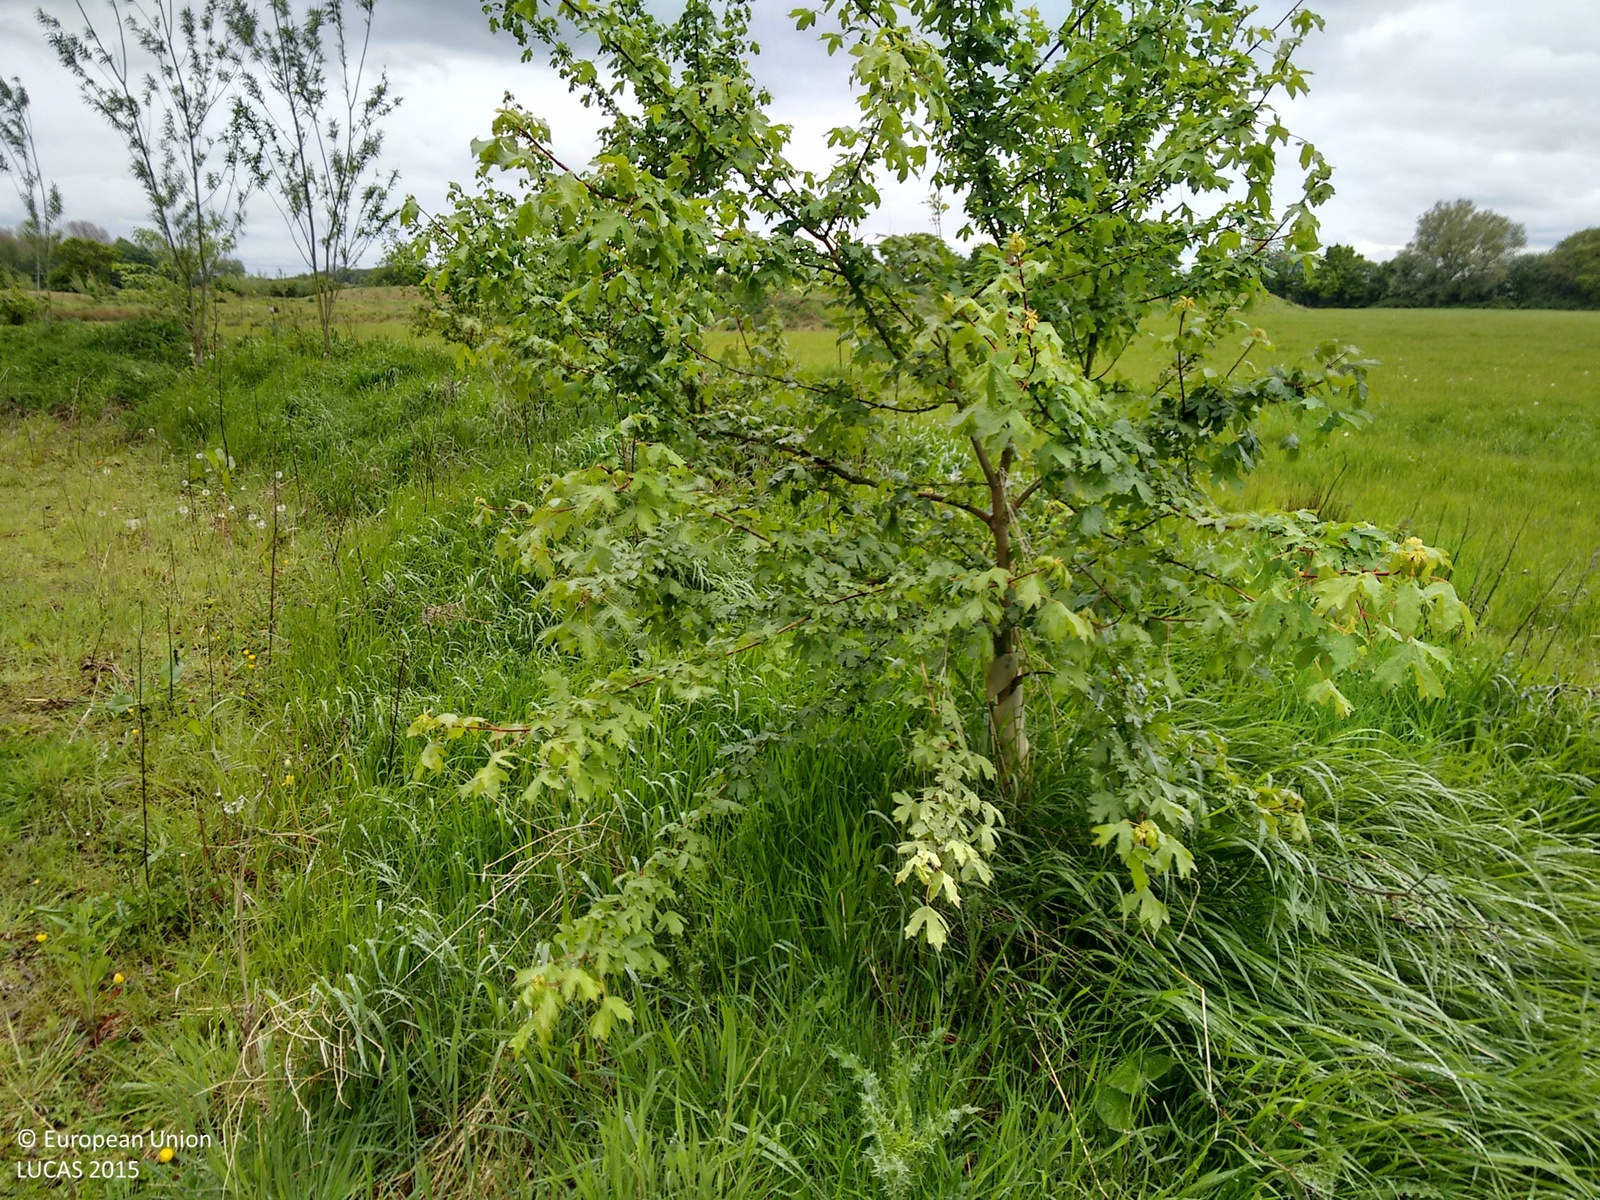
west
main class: Grassland
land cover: Grassland without tree/shrub cover
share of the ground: > 75 %
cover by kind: herbaceous plants 100 %
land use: Agriculture (excluding fallow land and kitchen gardens)
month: May
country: GB
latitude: 53.6138
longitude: -1.1249
